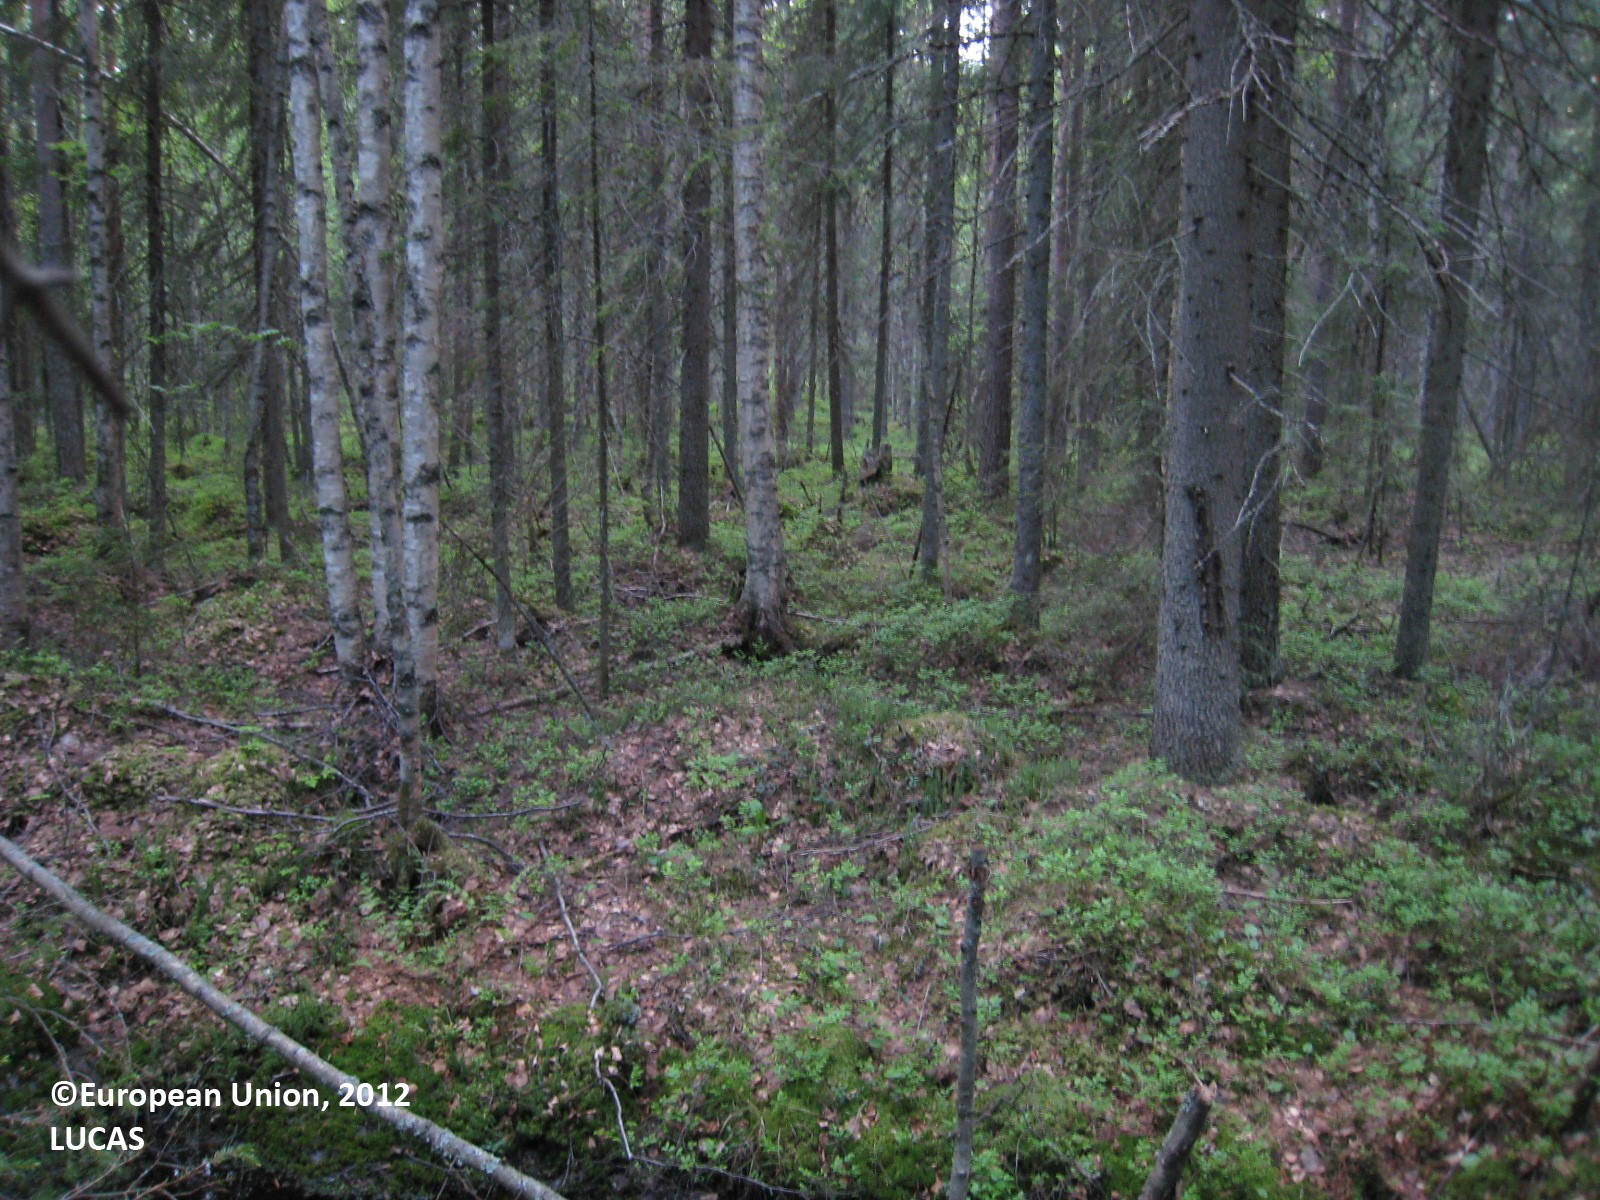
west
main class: Woodland
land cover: Spruce dominated mixed woodland
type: boreal forest
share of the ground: > 75 %
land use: Forestry
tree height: > 5 m
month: June
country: FI
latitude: 62.5686
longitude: 26.1005
